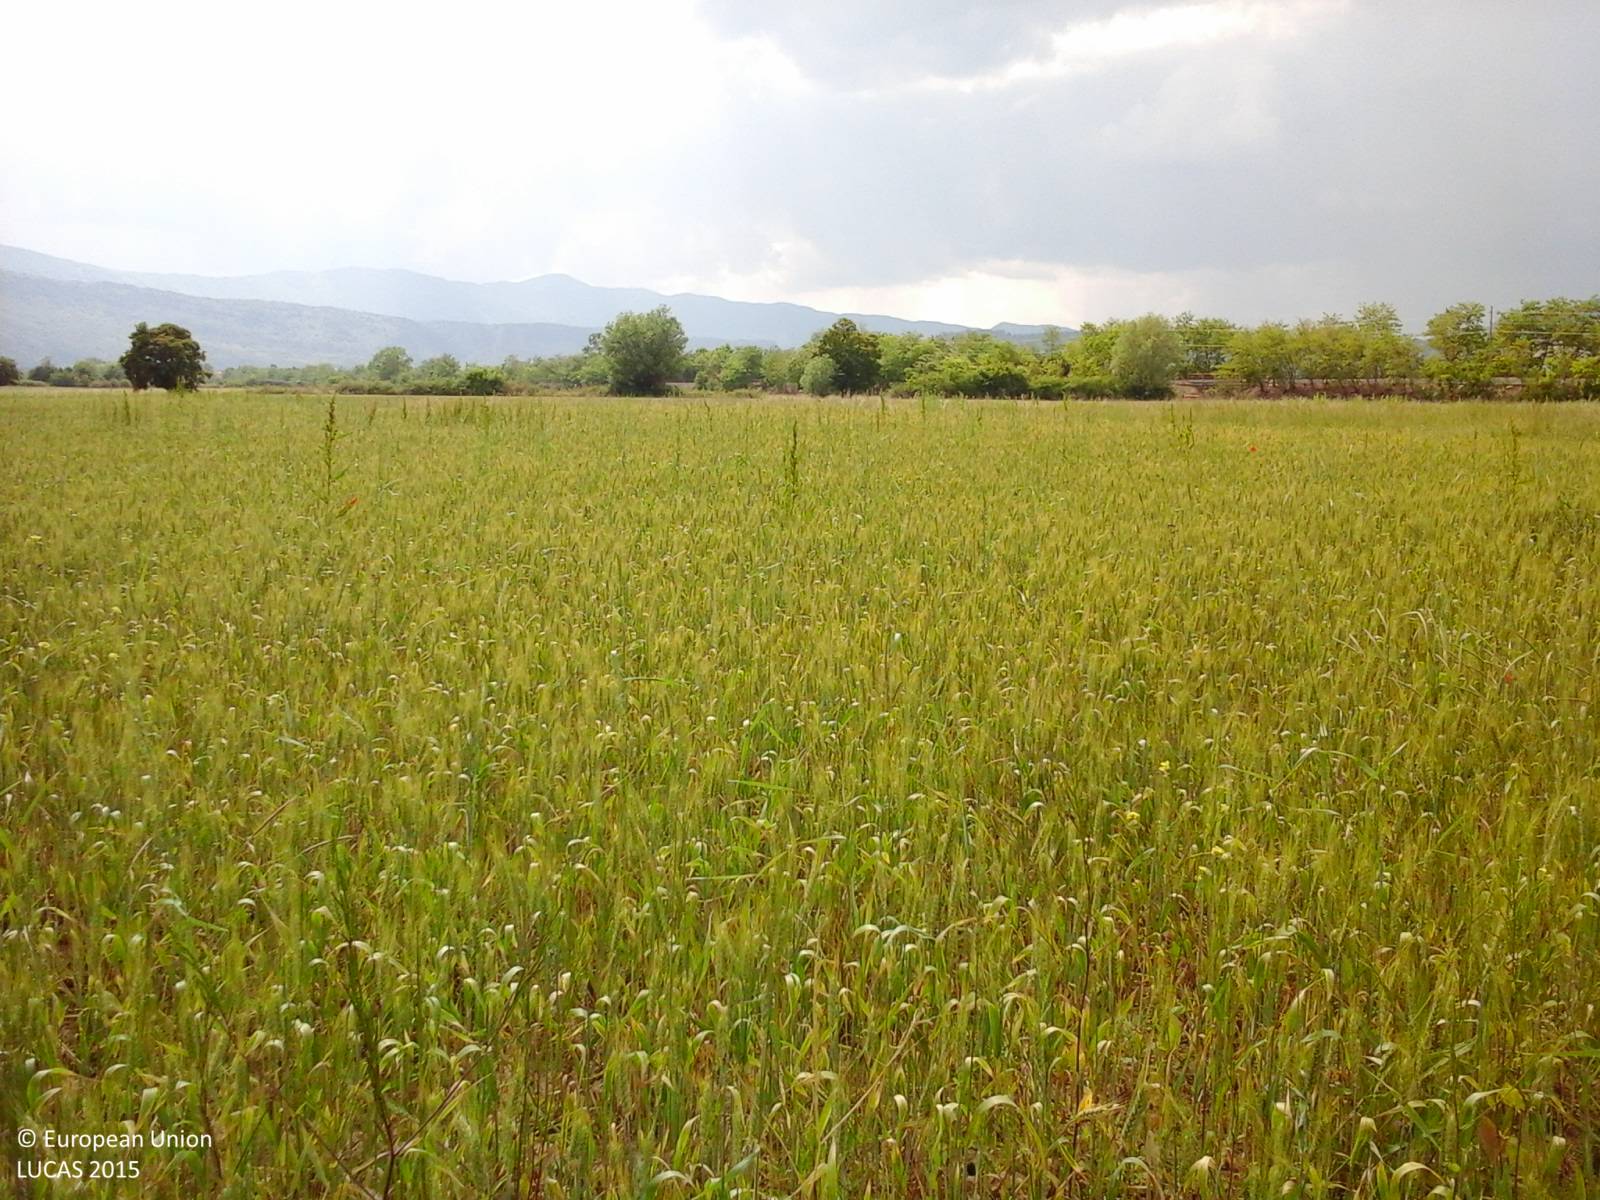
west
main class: Cropland
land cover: Common wheat
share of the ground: > 75 %
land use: Agriculture (excluding fallow land and kitchen gardens)
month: June
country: IT
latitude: 42.0559
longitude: 13.3597
